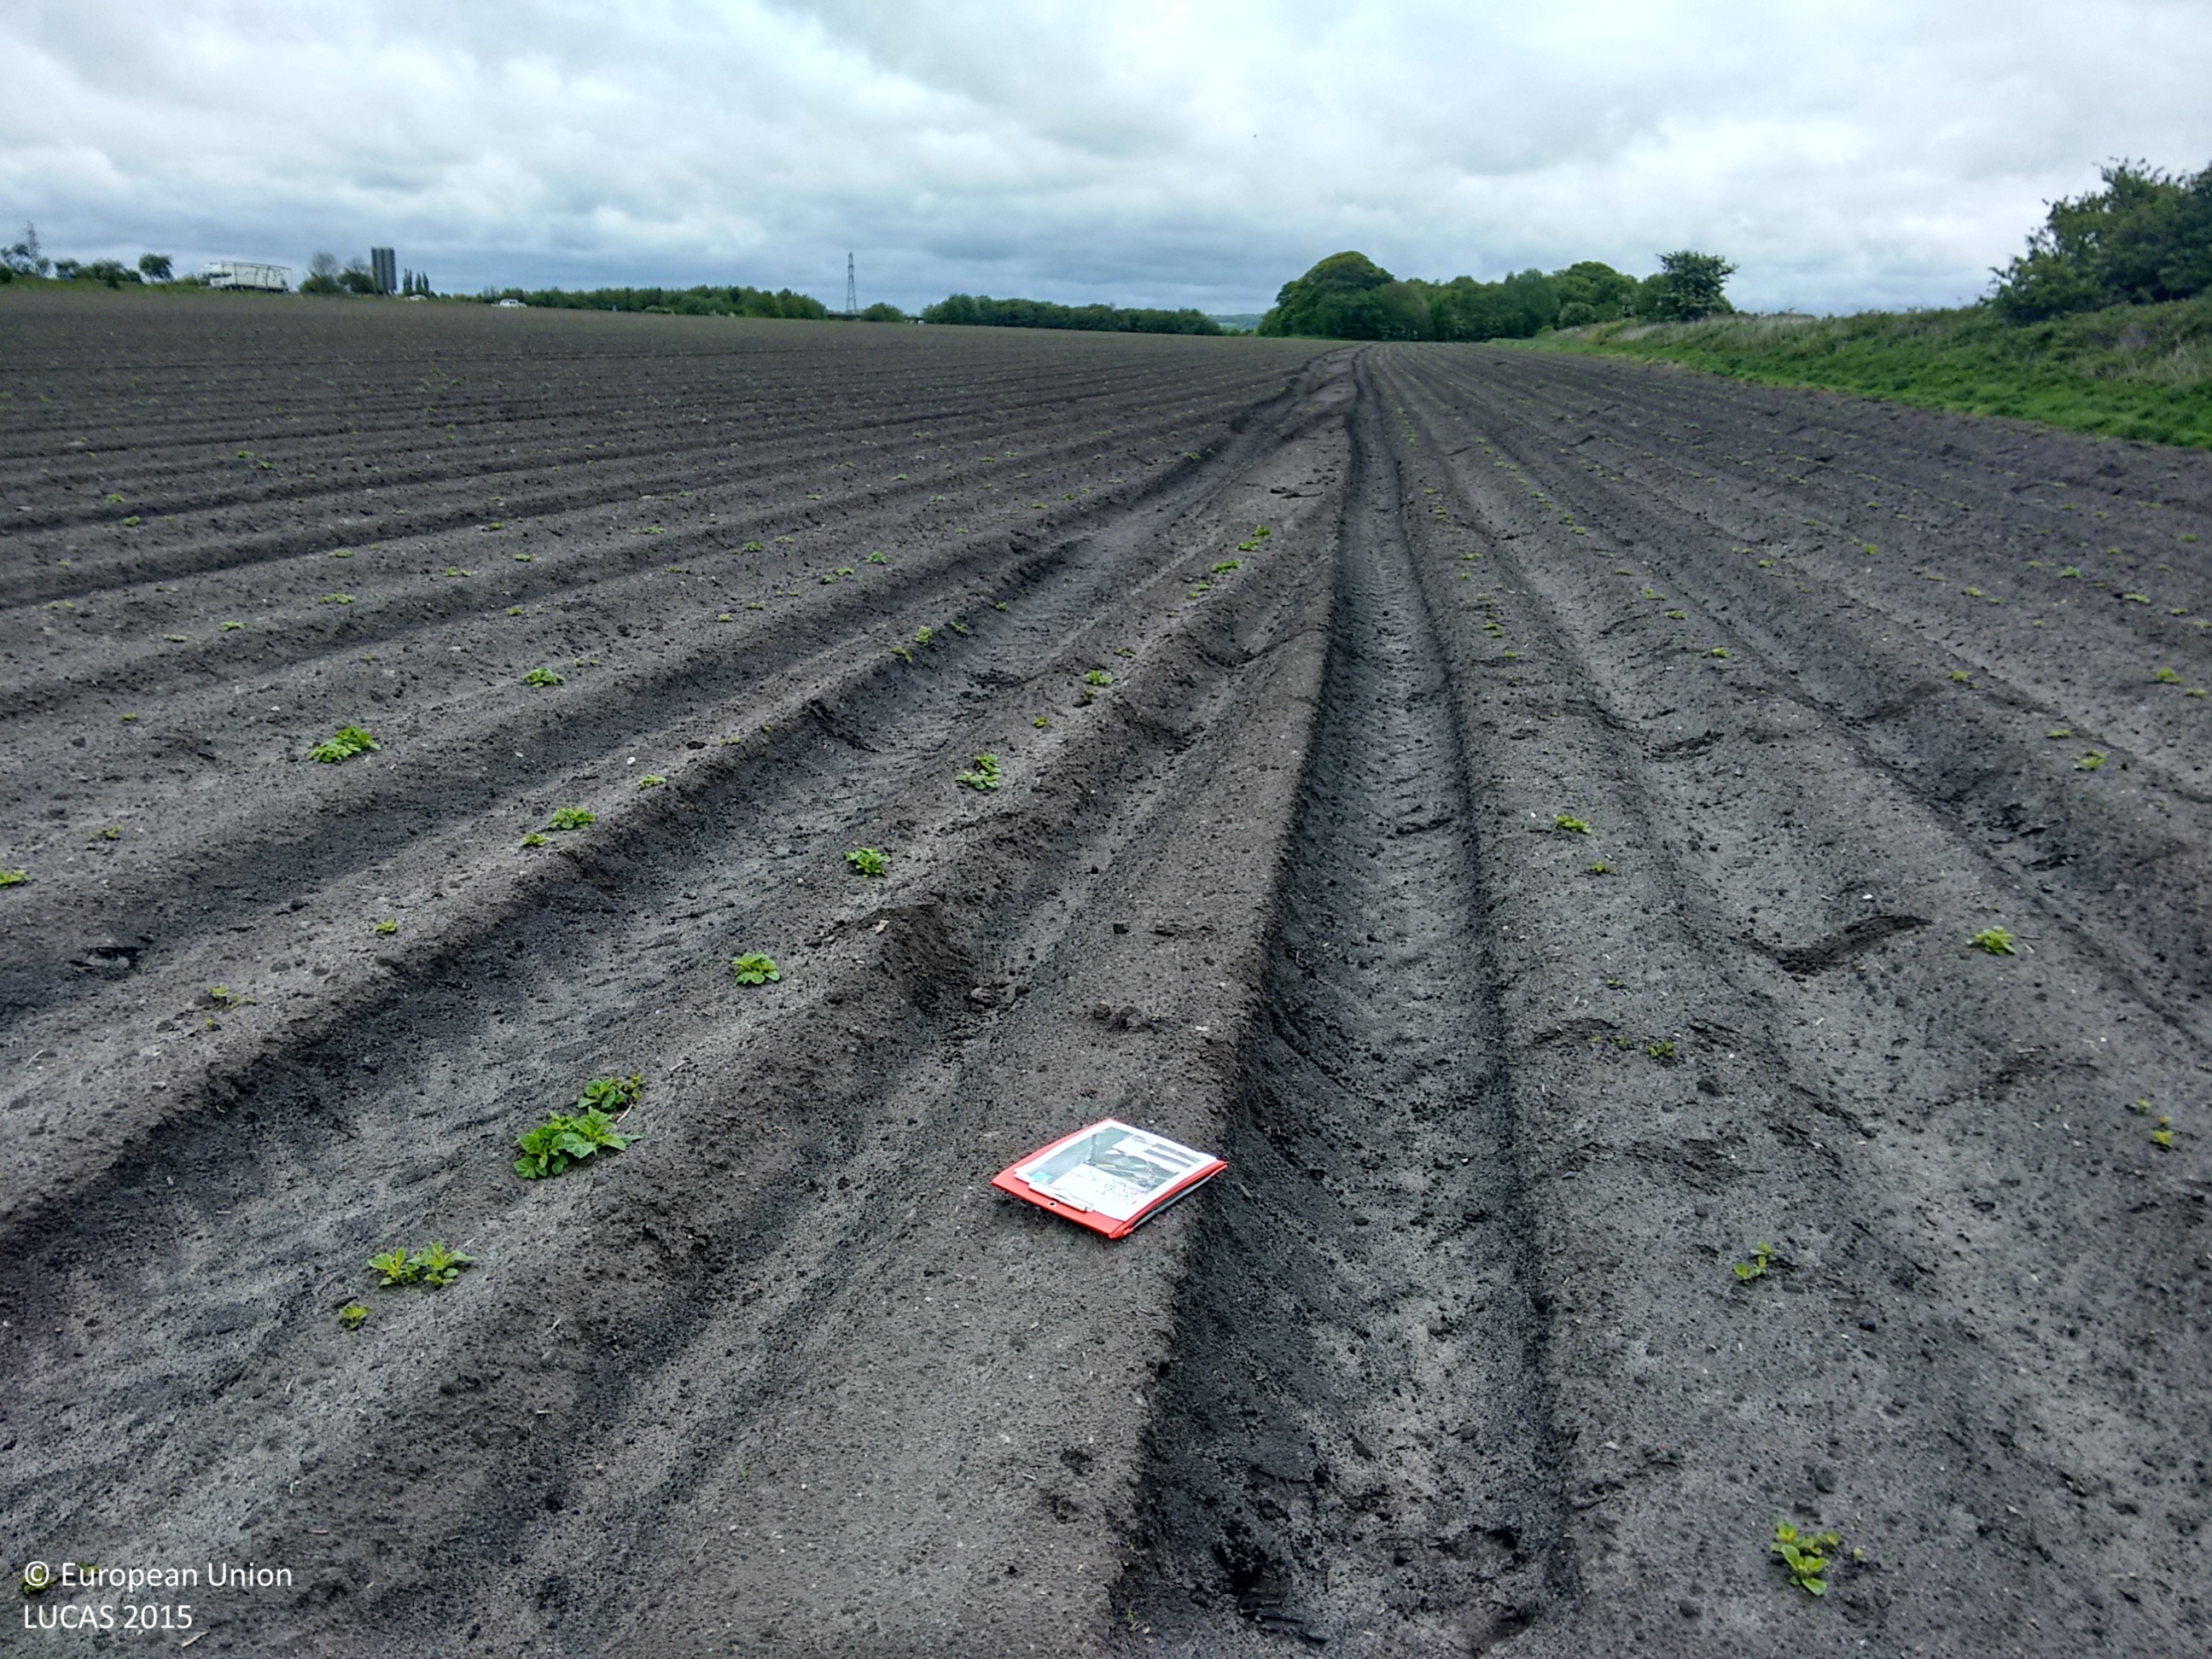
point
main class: Cropland
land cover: Potatoes
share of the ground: < 10 %
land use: Agriculture (excluding fallow land and kitchen gardens)
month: May
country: GB
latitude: 53.5366
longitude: -2.8207
